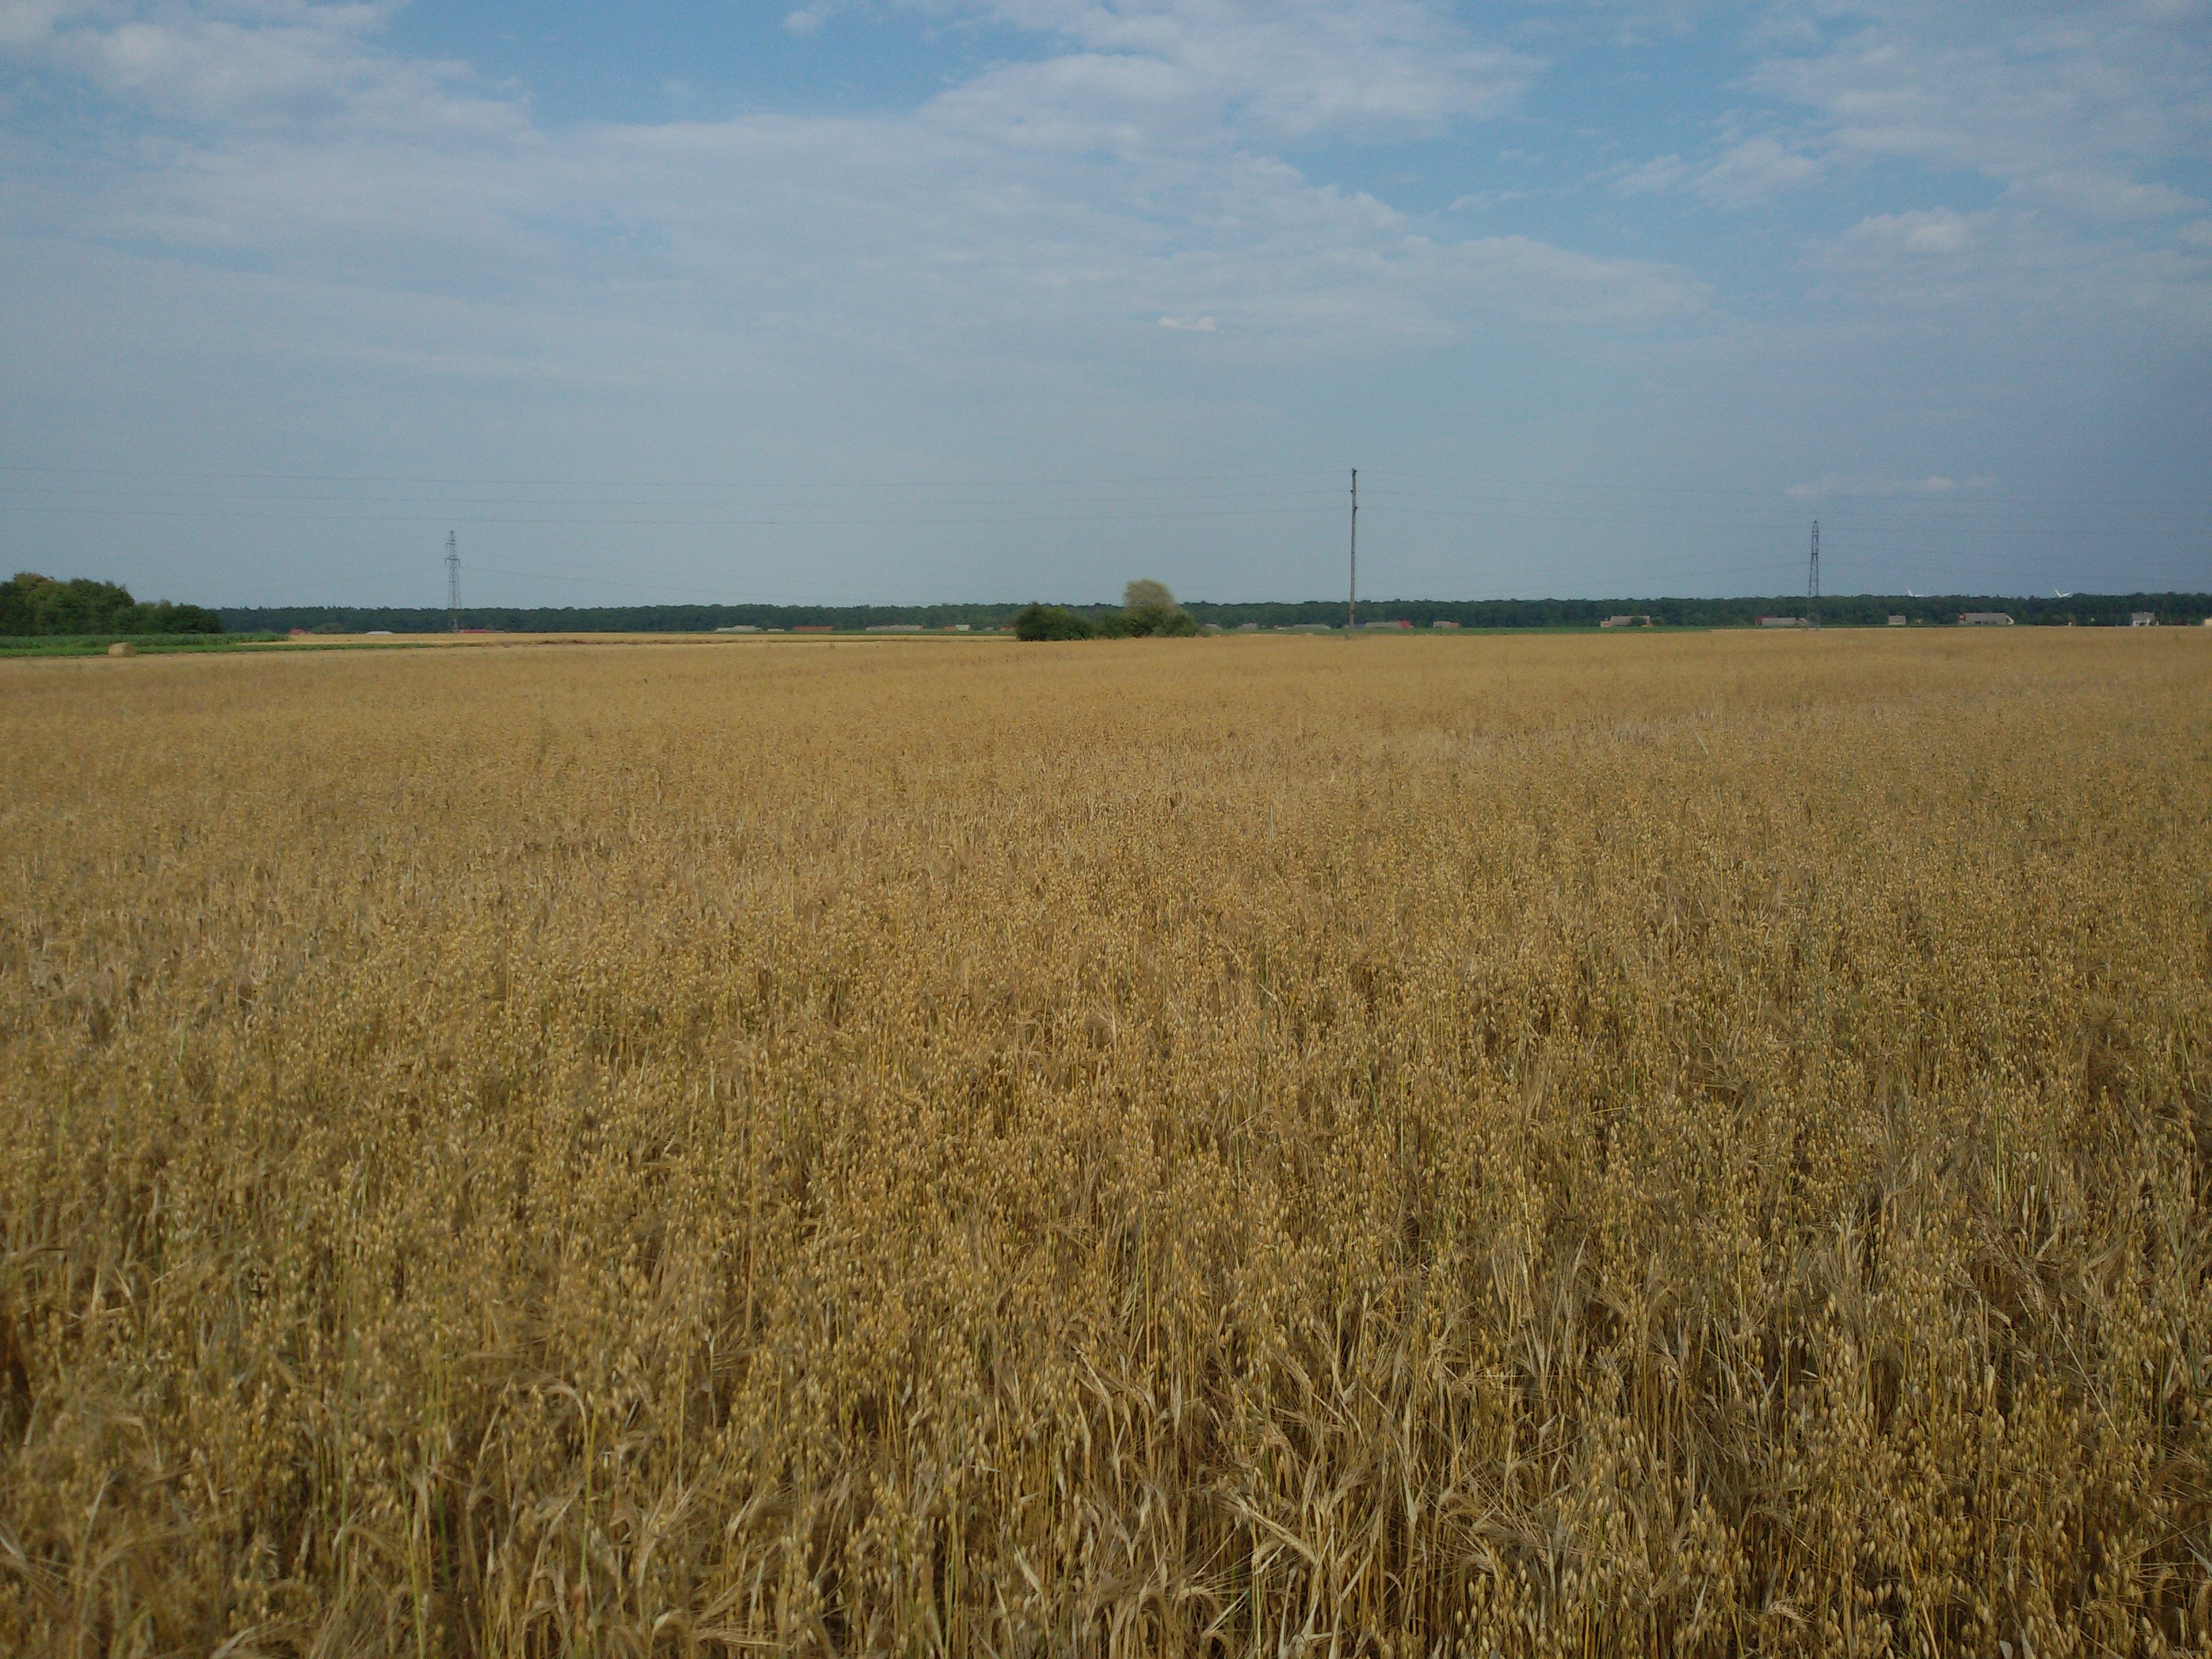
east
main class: Cropland
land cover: Barley
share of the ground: 25 - 50 %
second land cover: Oats
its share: 25 - 50 %
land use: Agriculture (excluding fallow land and kitchen gardens)
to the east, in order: Barley; Oats; Electric lines; Barley; Spontaneously vegetated surfaces; Ditches and canals; Shrubland with sparse tree cover
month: July
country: PL
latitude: 51.8055
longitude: 17.0733
